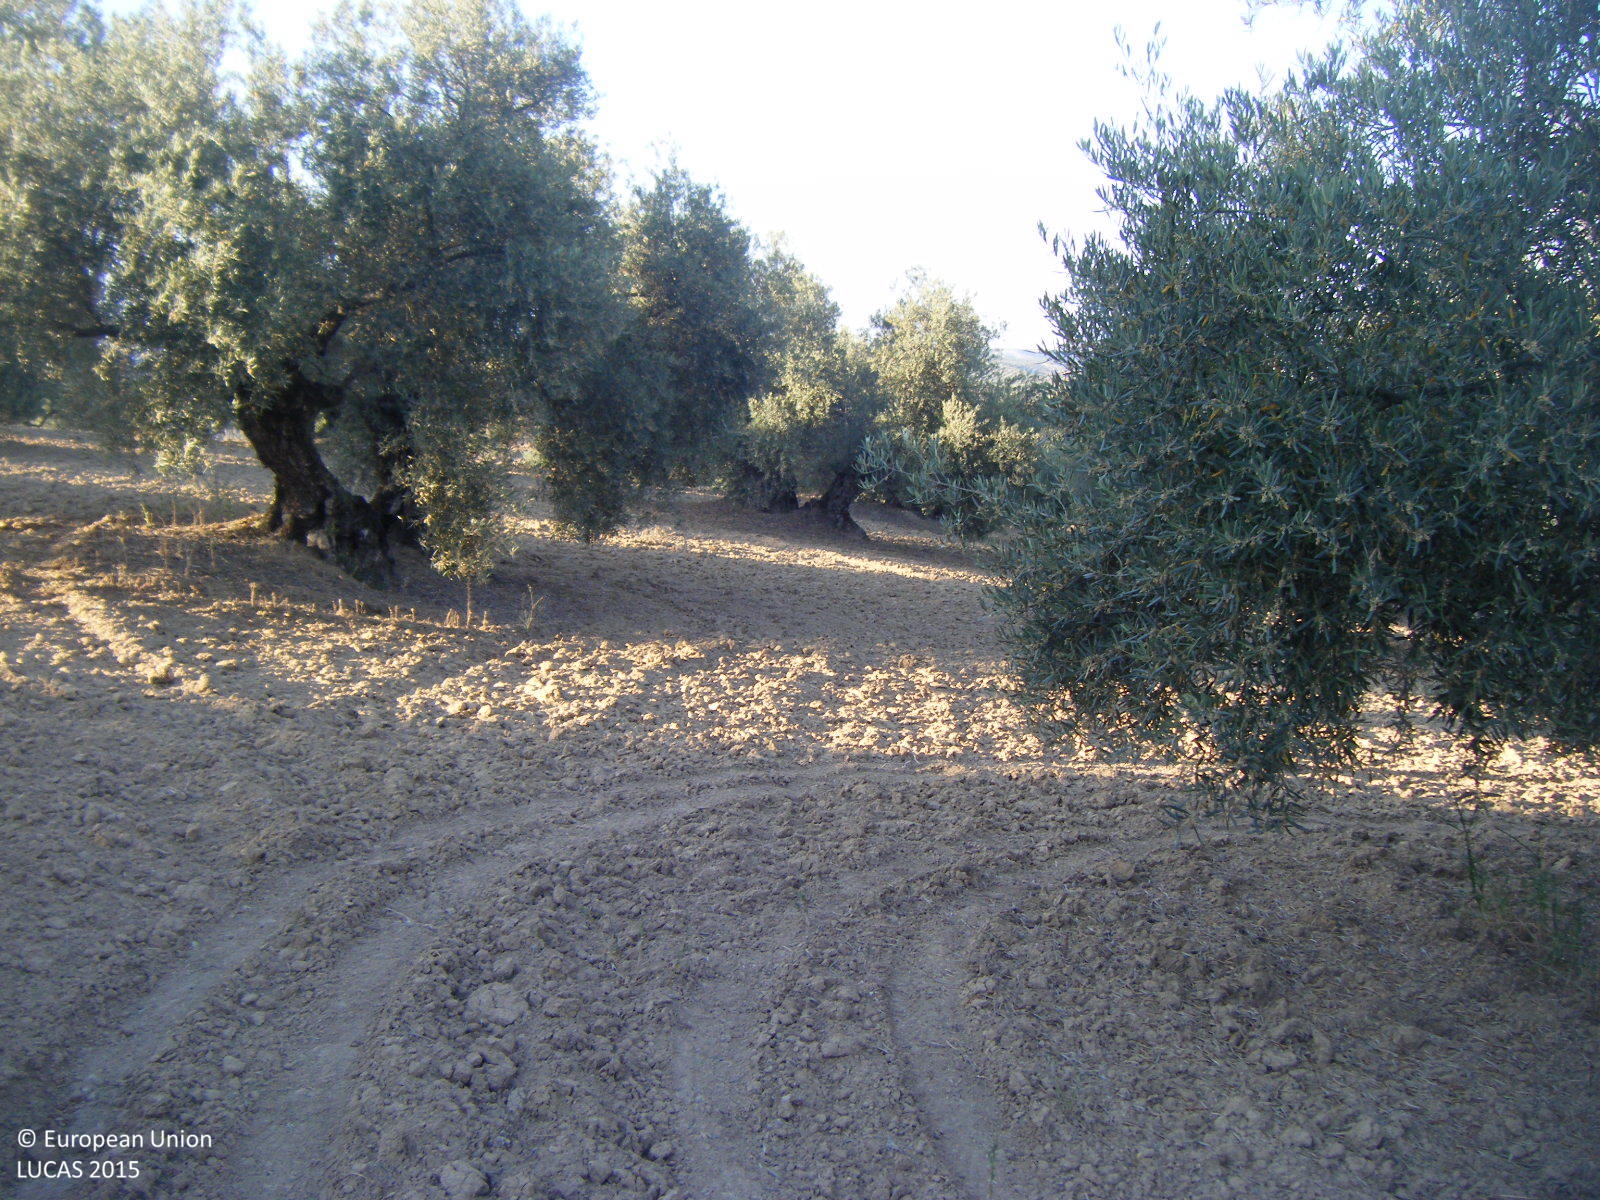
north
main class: Cropland
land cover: Olive groves
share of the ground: 25 - 50 %
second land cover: Other bare soil
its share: > 75 %
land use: Agriculture (excluding fallow land and kitchen gardens)
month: May
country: ES
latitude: 37.2356
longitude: -4.5068
